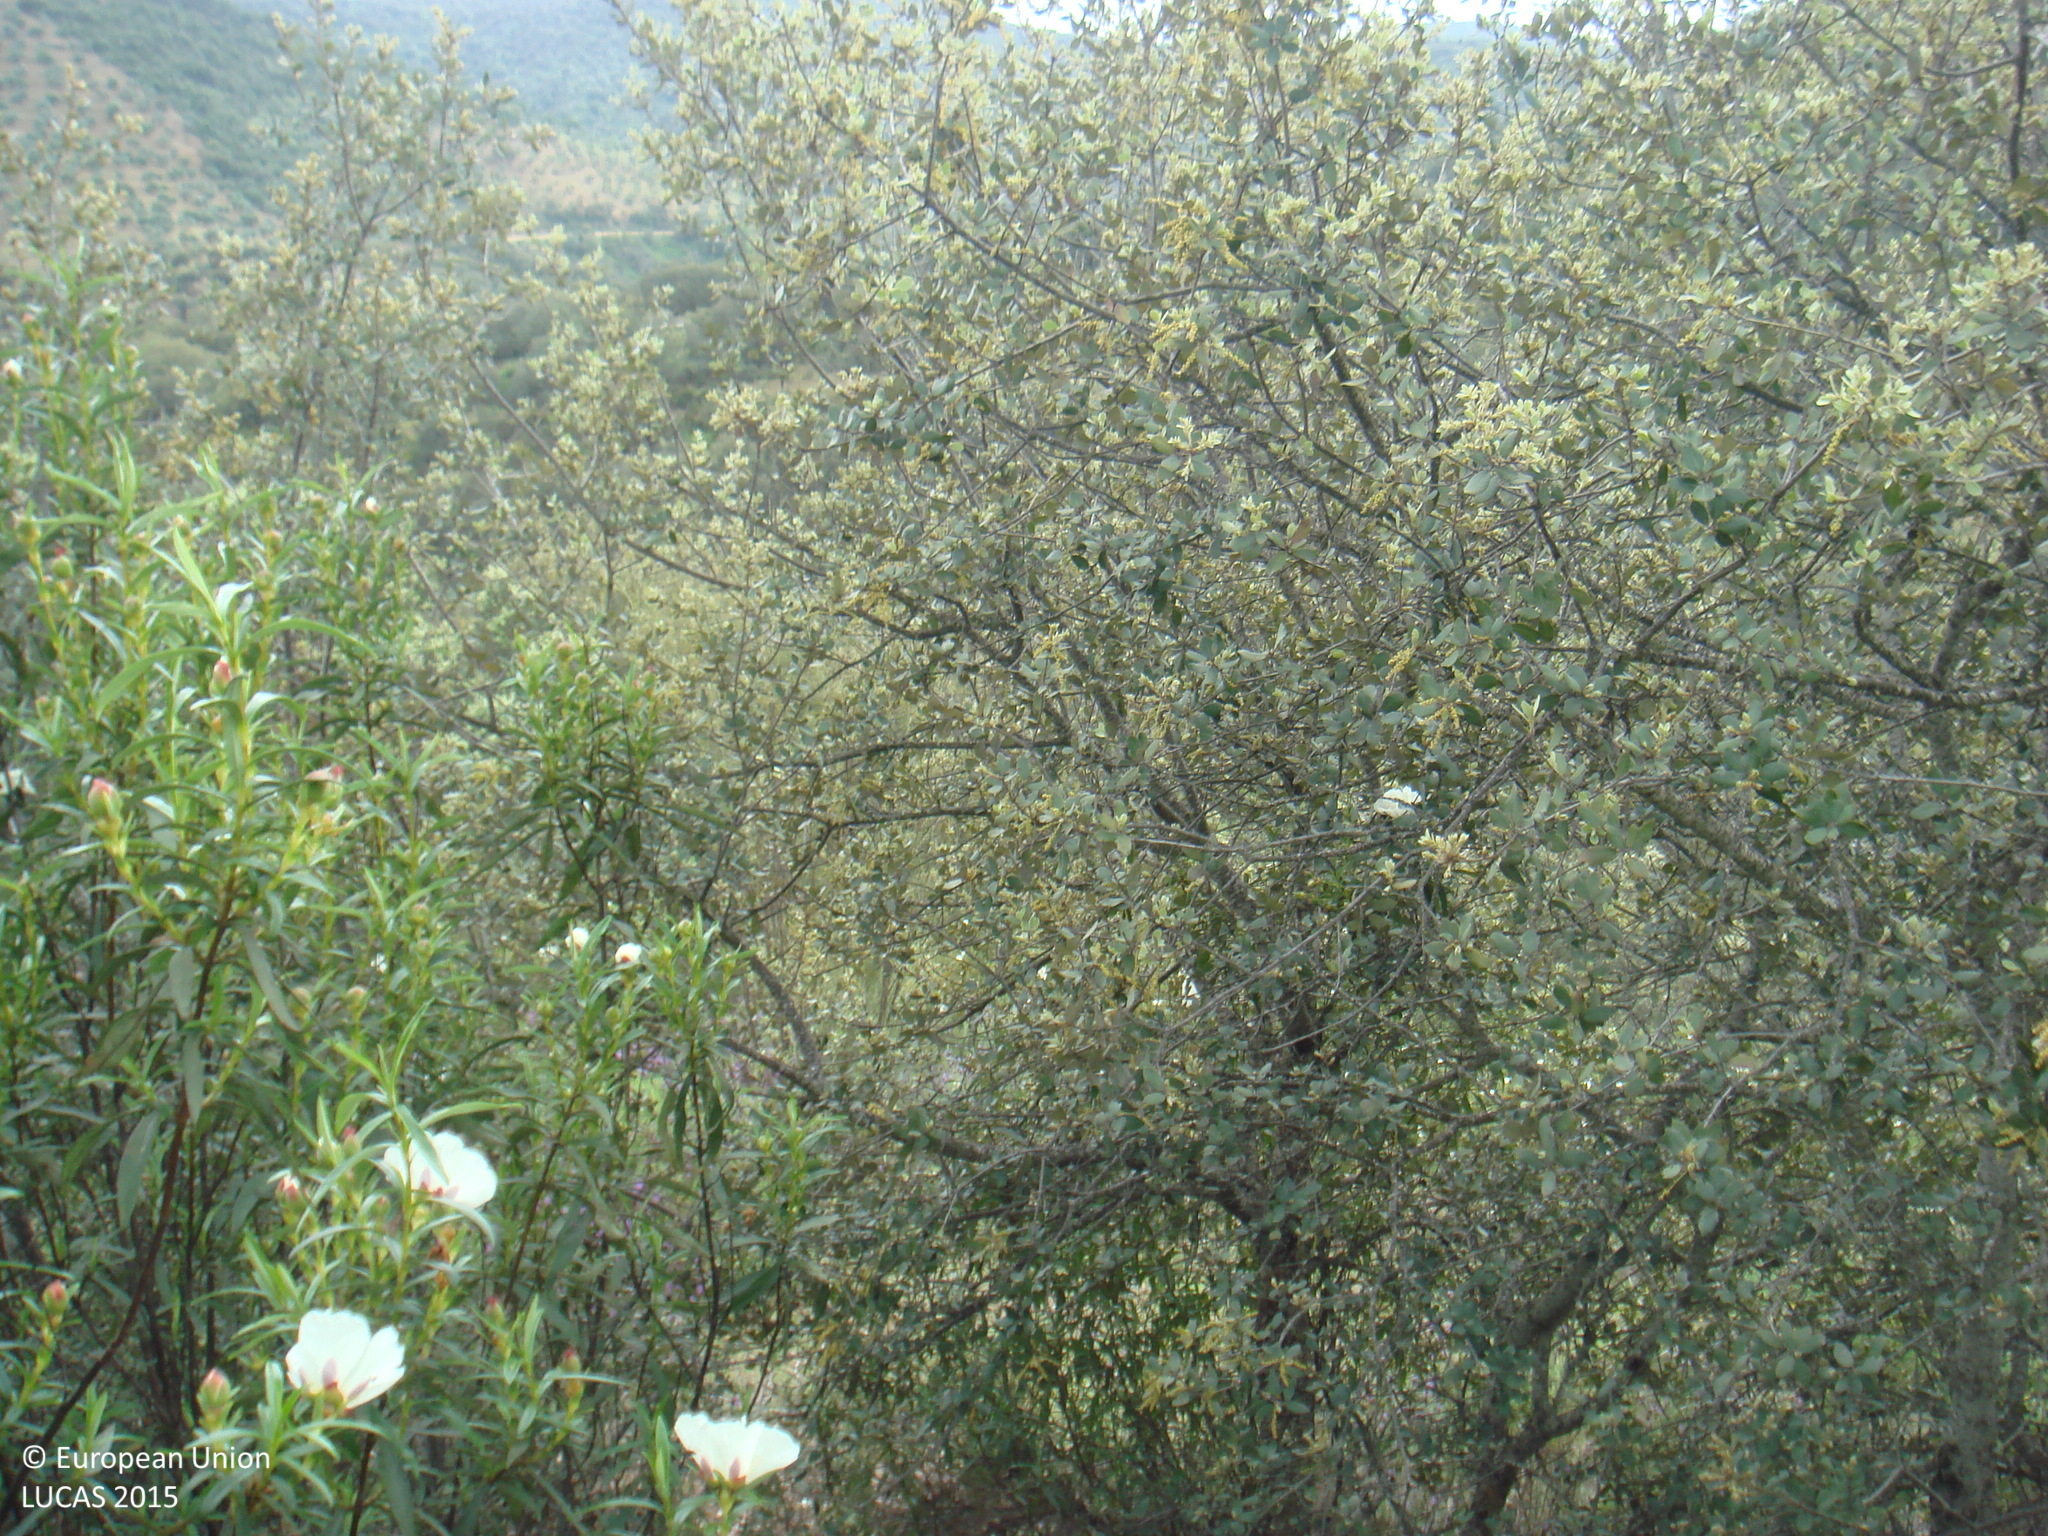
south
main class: Woodland
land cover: Broadleaved woodland
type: broadleaved evergreen forest
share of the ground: 10 - 25 %
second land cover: Shrubland without tree cover
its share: 50 - 75 %
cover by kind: shrubs 65 %, broadleaved forest trees 20 %, unconsolidated bare surface 10 %, herbaceous plants 5 %
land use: Forestry
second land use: Agriculture (excluding fallow land and kitchen gardens)
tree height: < 5 m
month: April
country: ES
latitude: 38.1610
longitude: -5.0538
